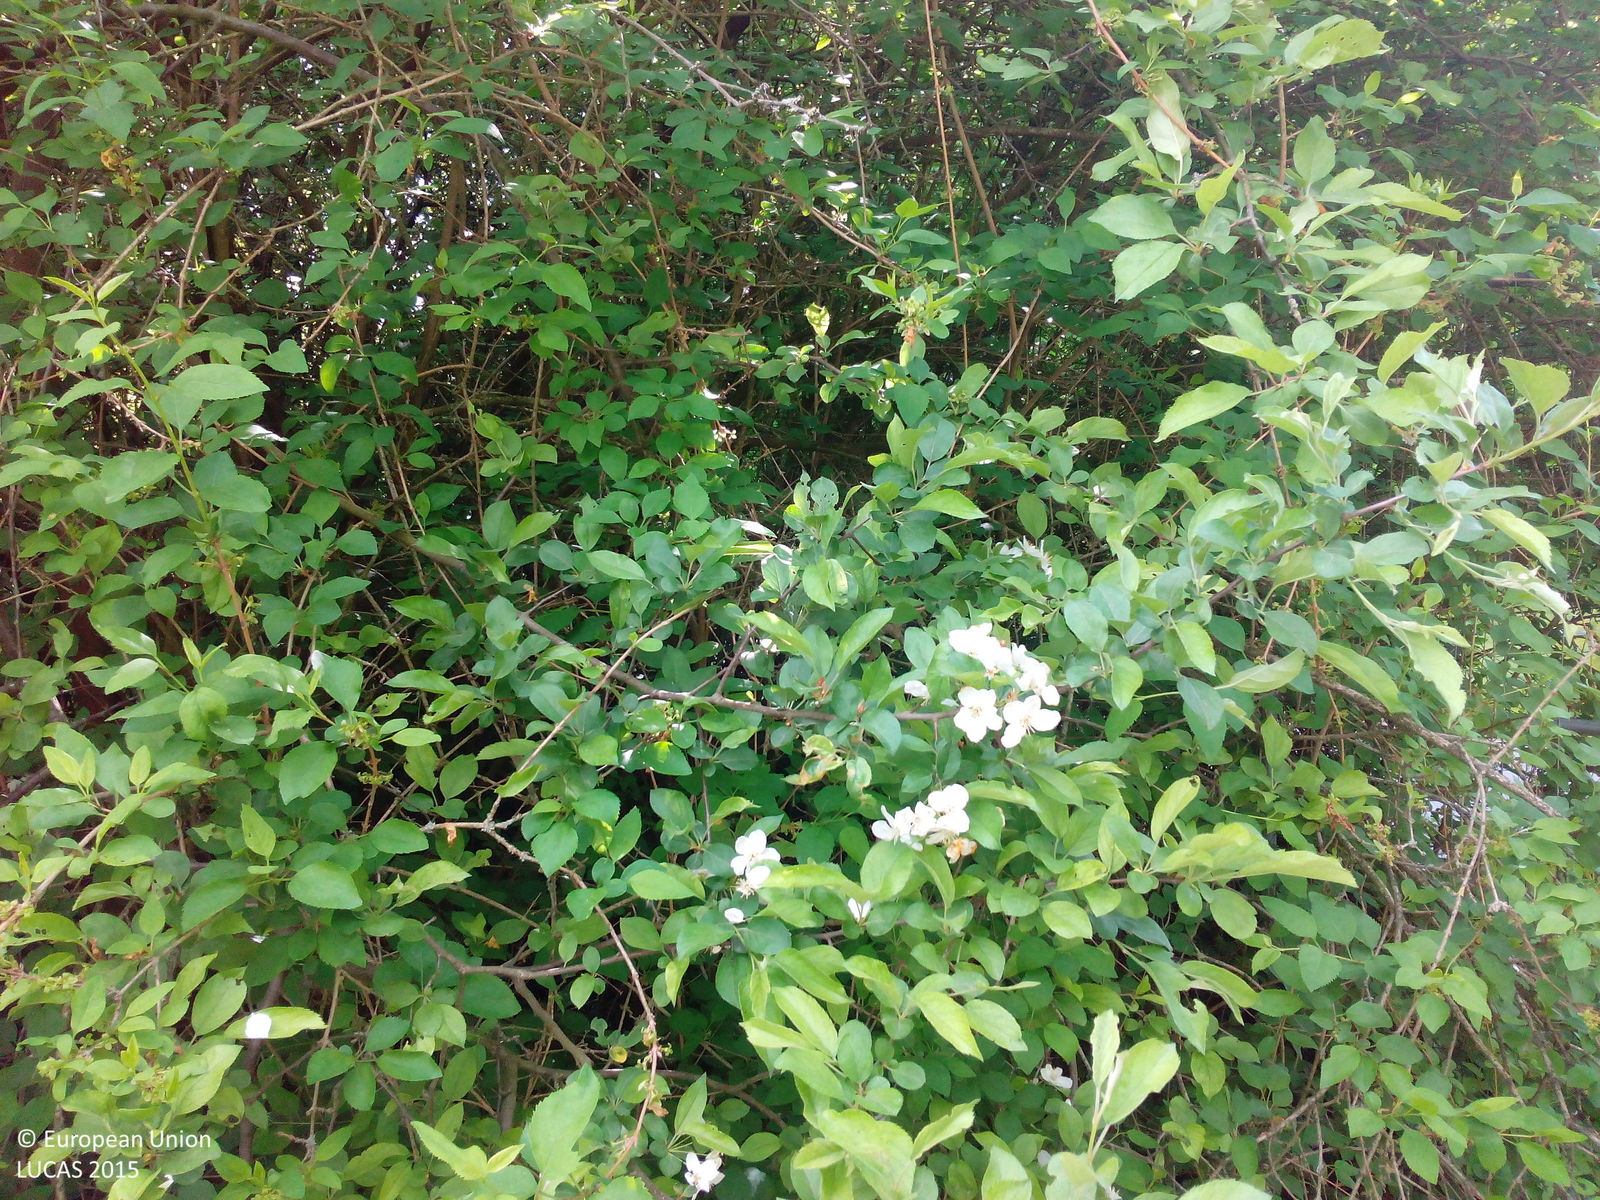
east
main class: Shrubland
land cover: Shrubland without tree cover
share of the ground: > 75 %
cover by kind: shrubs 100 %
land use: Road transport
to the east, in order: Shrubland without tree cover; Artificial constructions in urban areas; Ditches and canals; Artificial constructions in urban areas
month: May
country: DE
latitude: 51.8736
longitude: 9.6370
